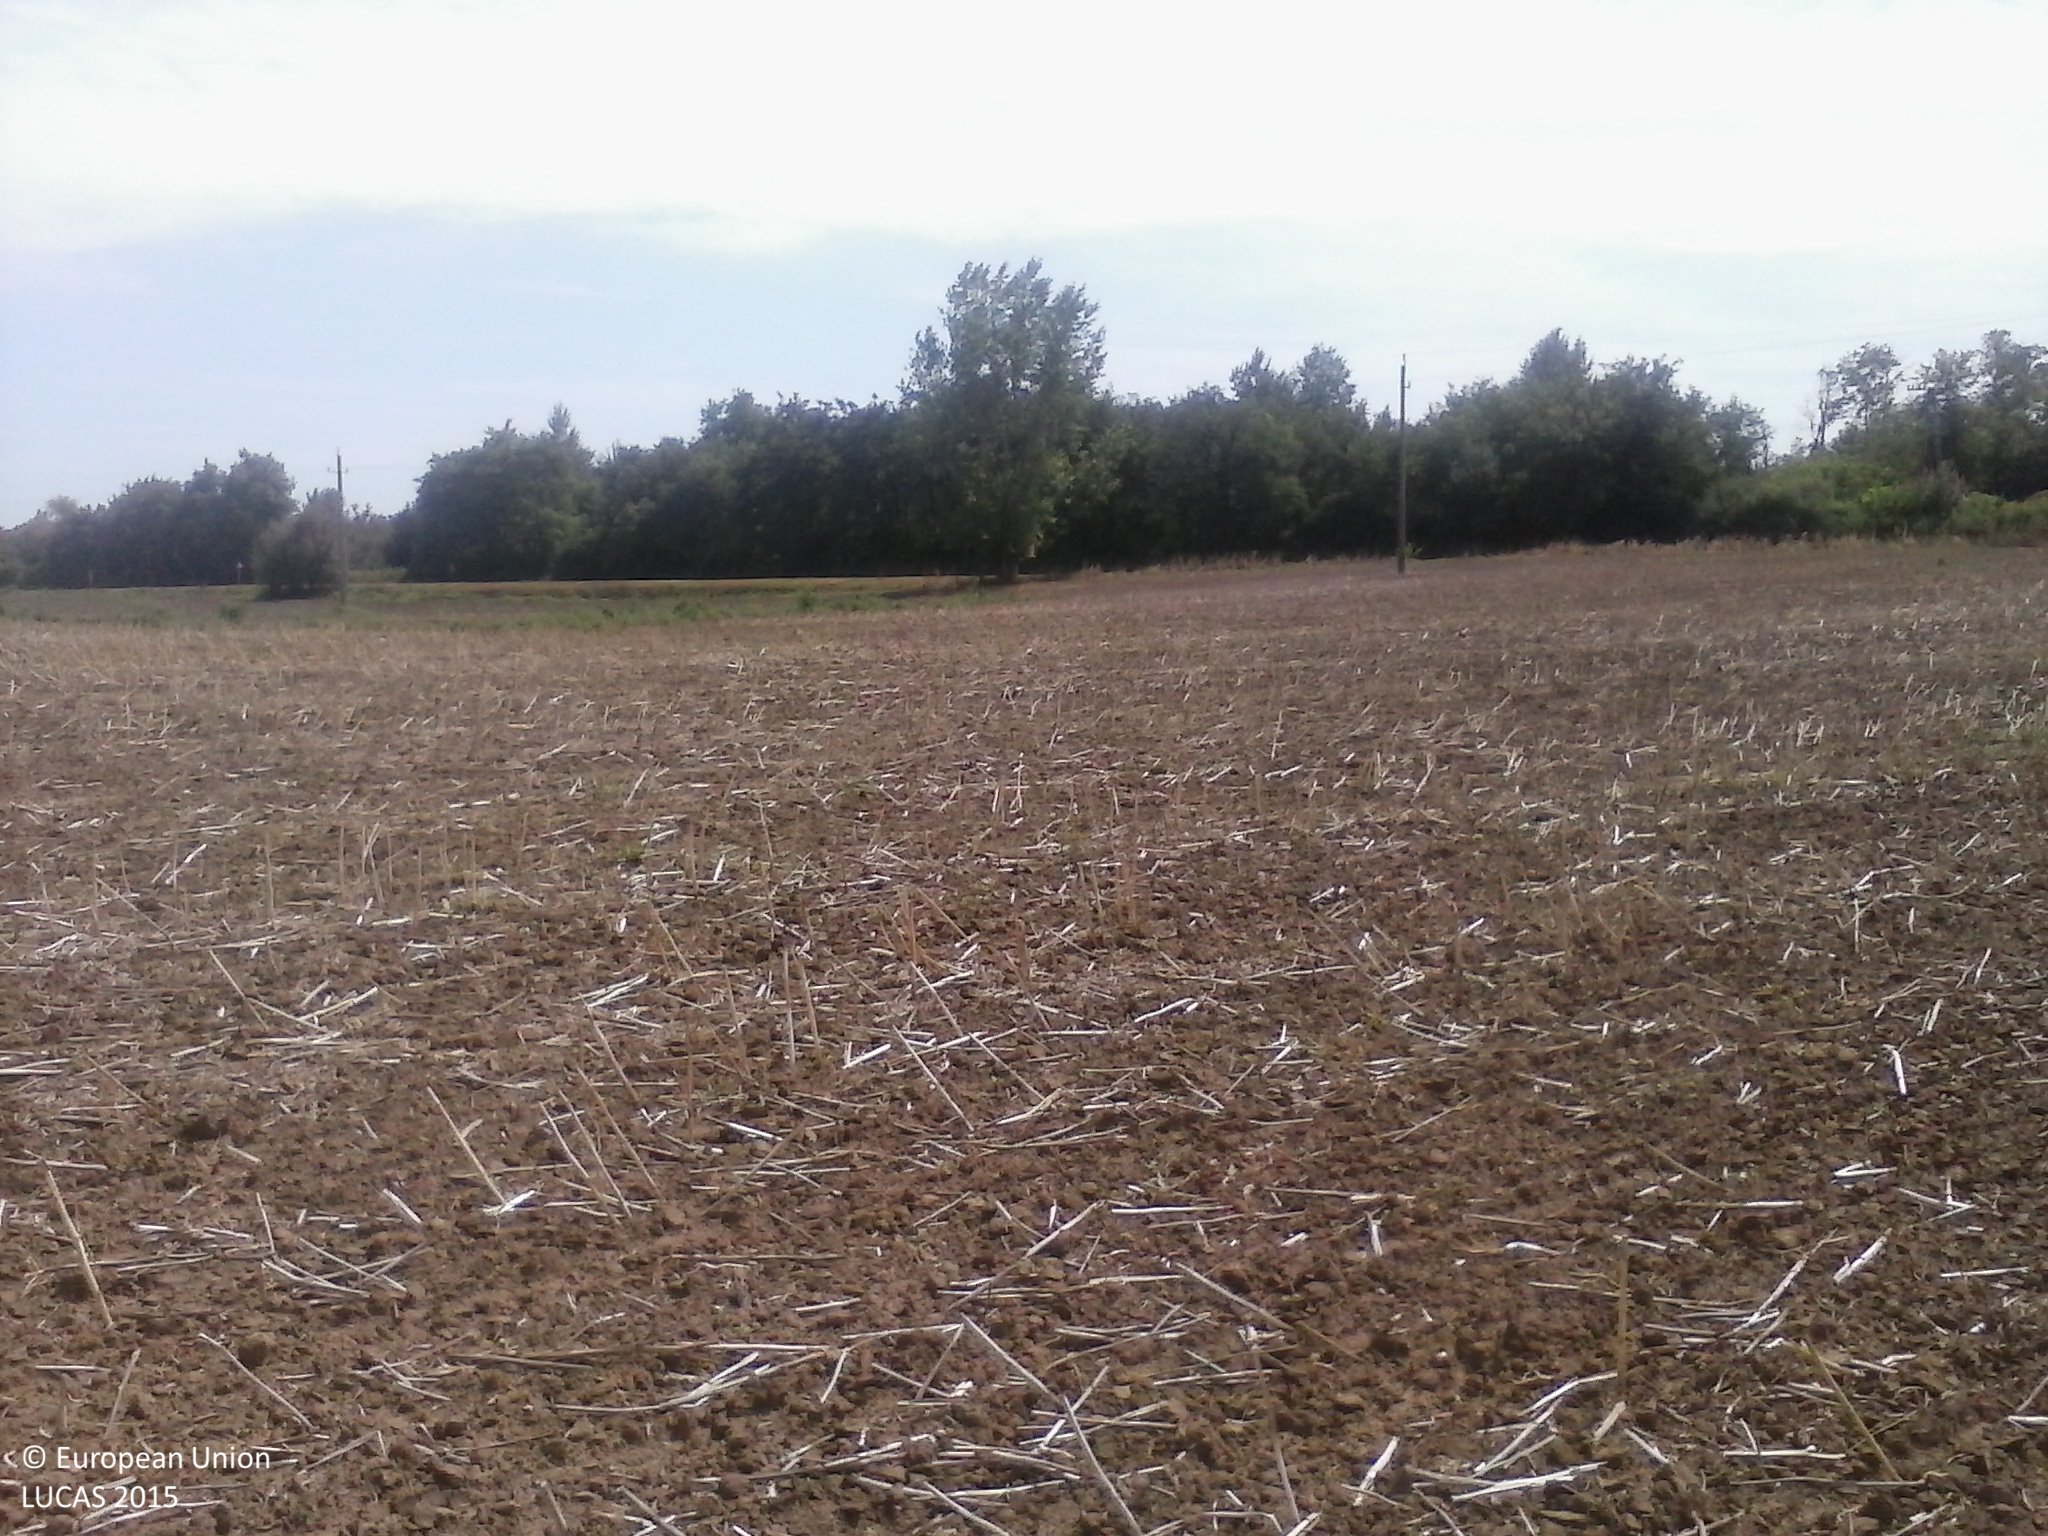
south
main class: Cropland
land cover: Rape and turnip rape
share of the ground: < 10 %
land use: Agriculture (excluding fallow land and kitchen gardens)
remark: Harvested field
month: July
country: HU
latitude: 46.1061
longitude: 17.2344
